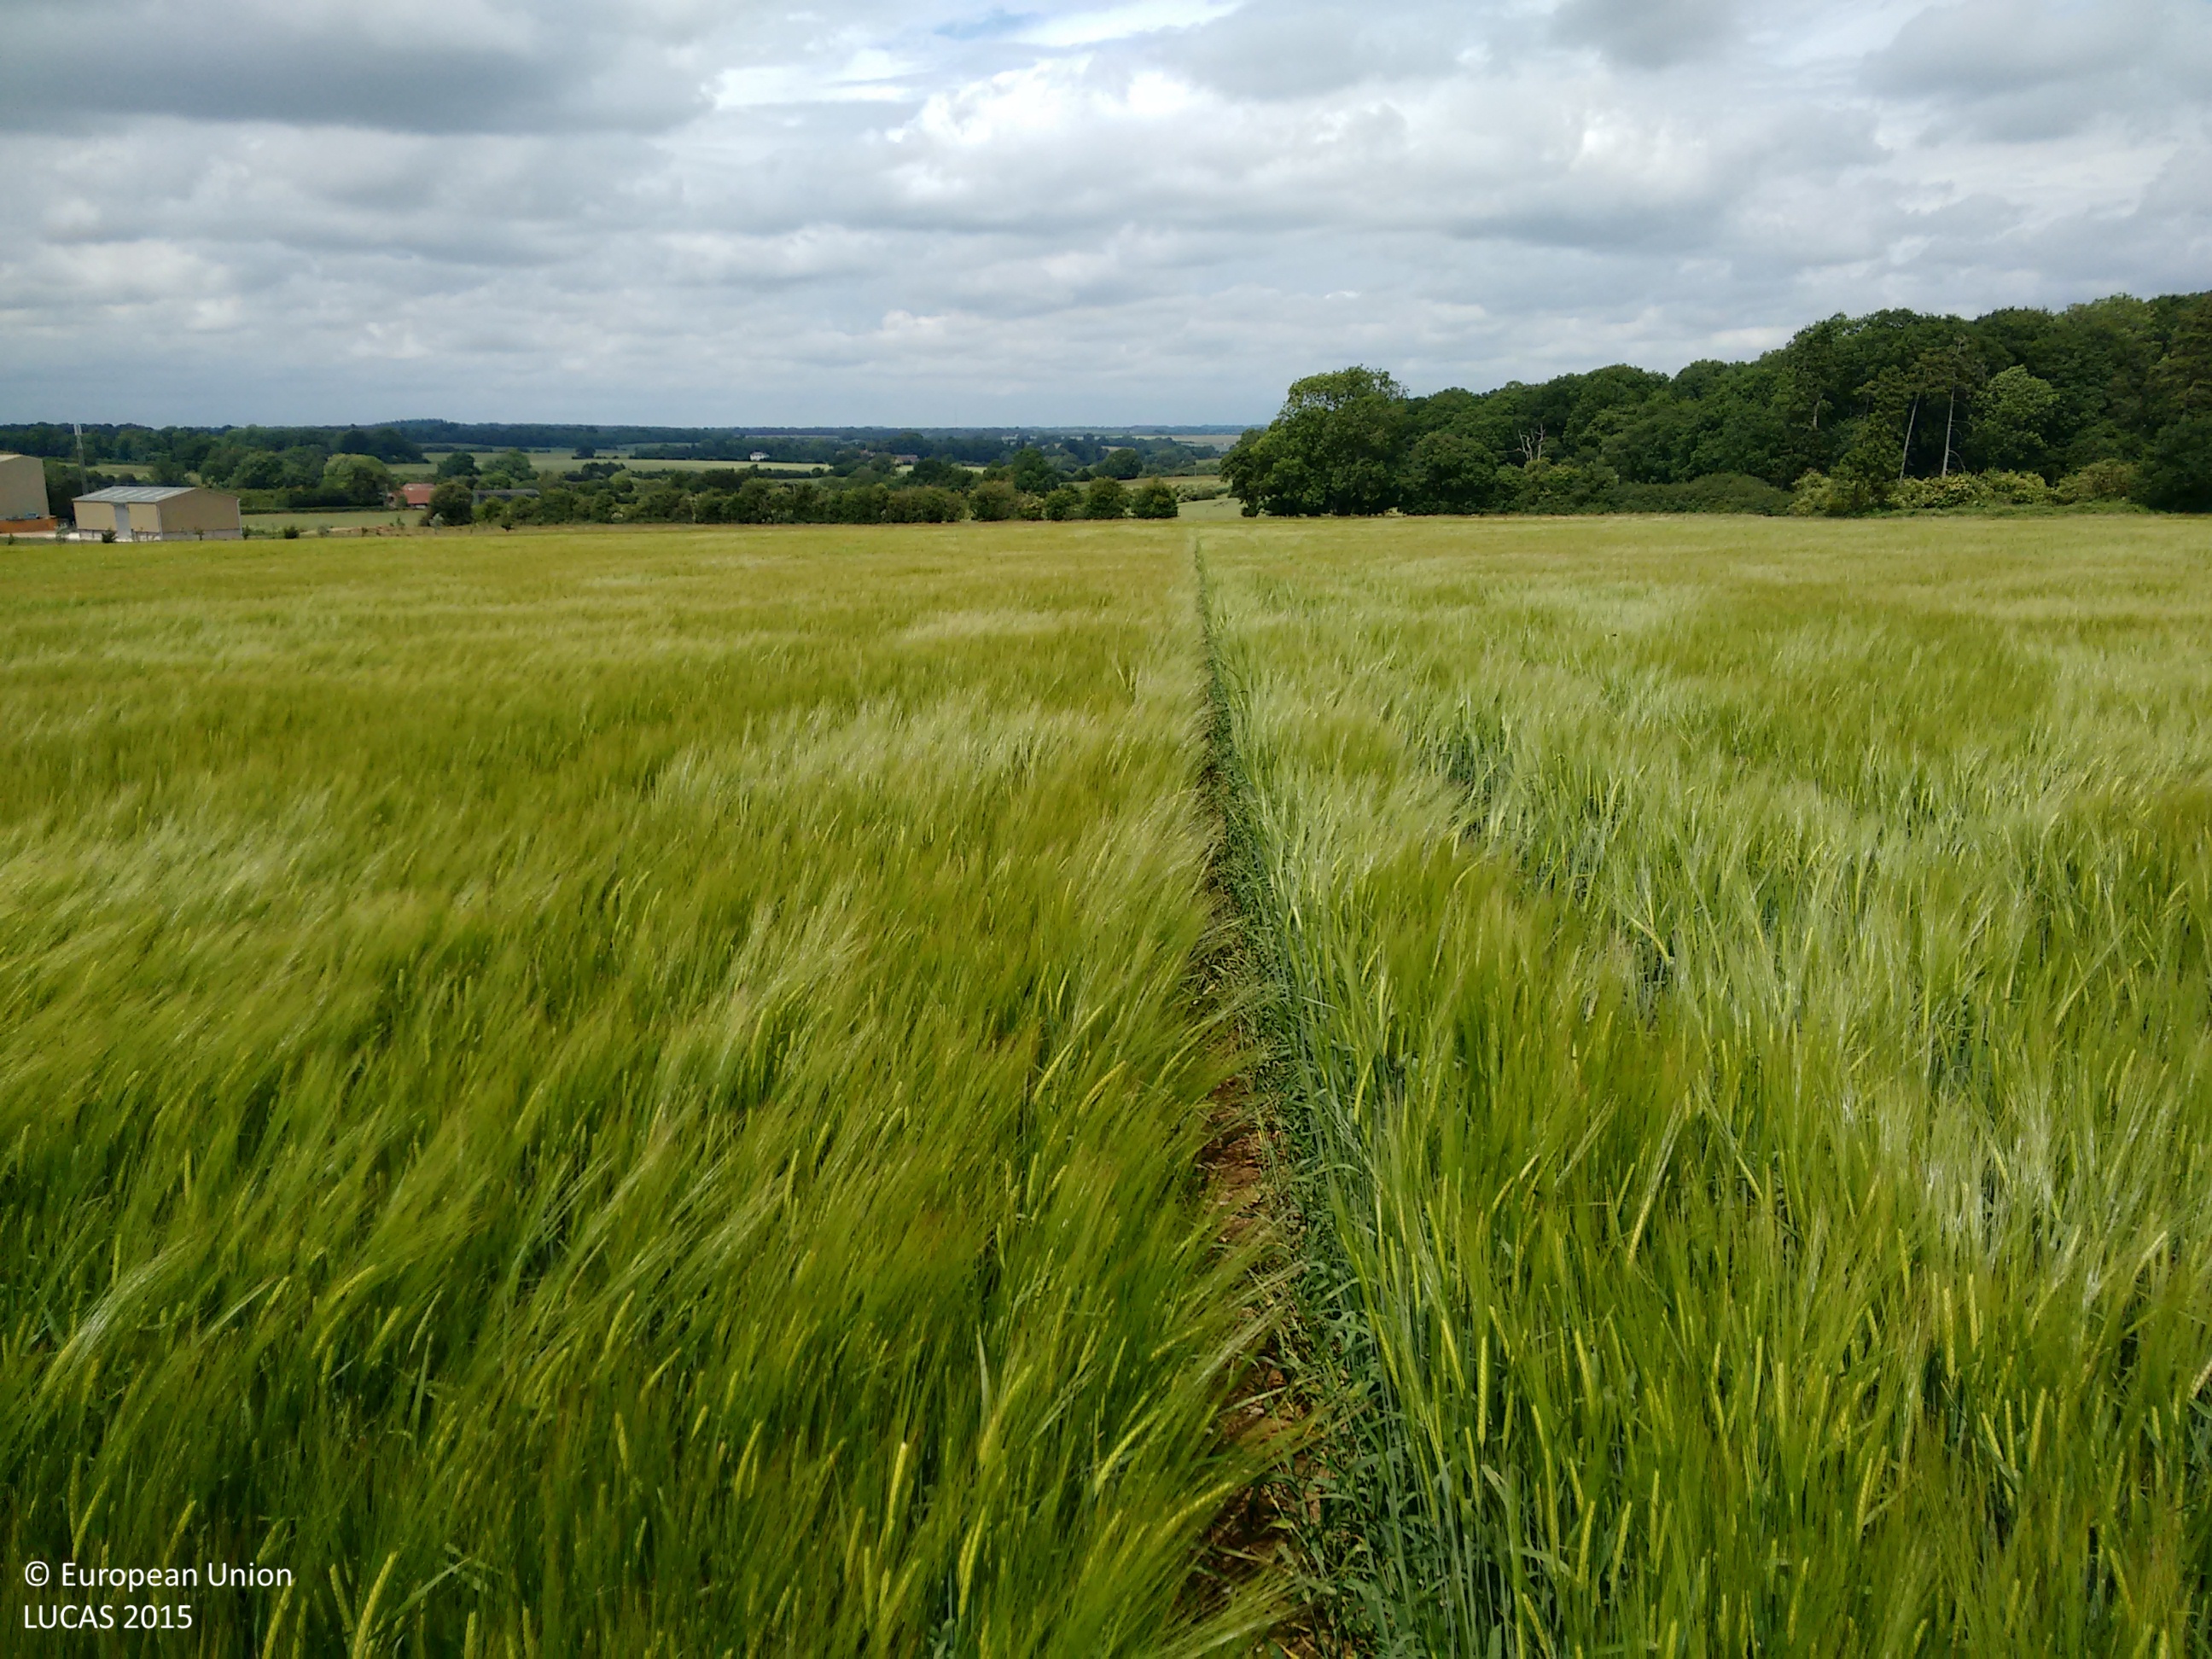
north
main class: Cropland
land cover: Barley
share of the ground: > 75 %
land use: Agriculture (excluding fallow land and kitchen gardens)
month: June
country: GB
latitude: 51.3774
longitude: -1.5307
